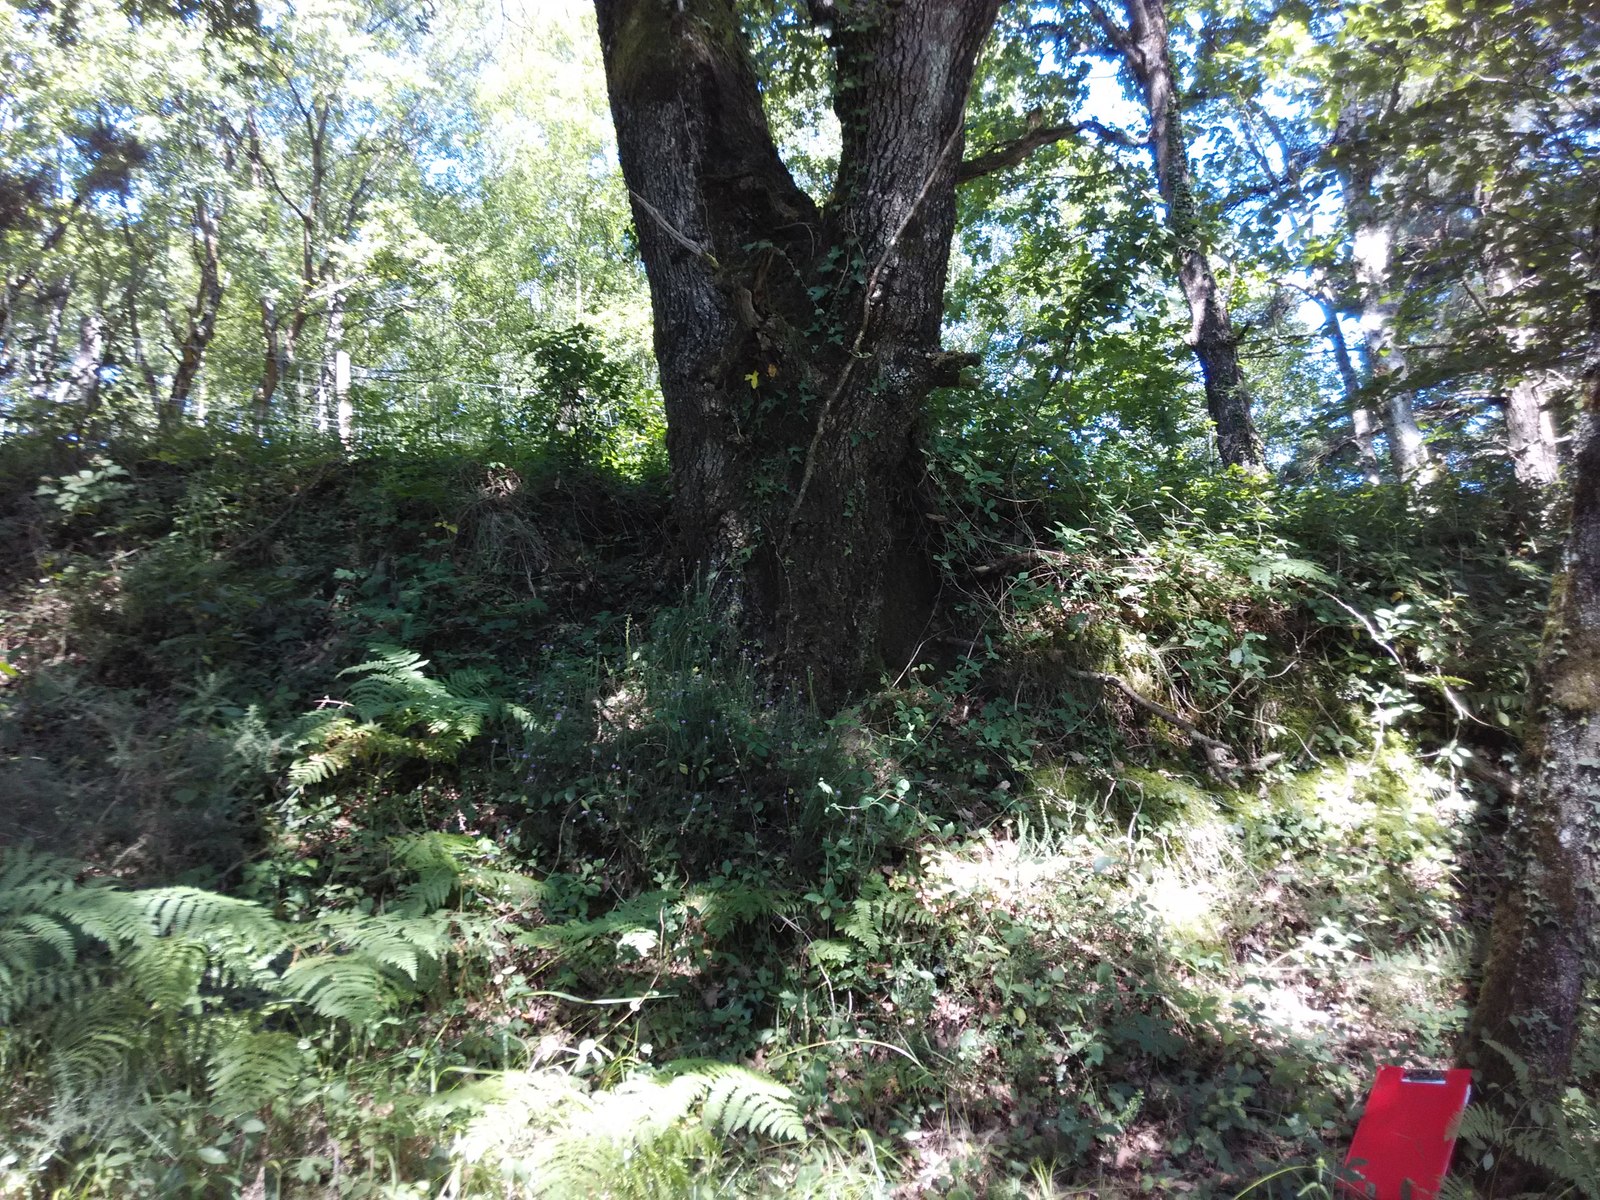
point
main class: Woodland
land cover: Broadleaved woodland
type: acidophilous oak and oak-birch forest
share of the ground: > 75 %
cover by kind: broadleaved forest trees 90 %, unconsolidated bare surface 10 %
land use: Forestry
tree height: > 5 m
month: July
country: ES
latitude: 43.0044
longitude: -2.2290
